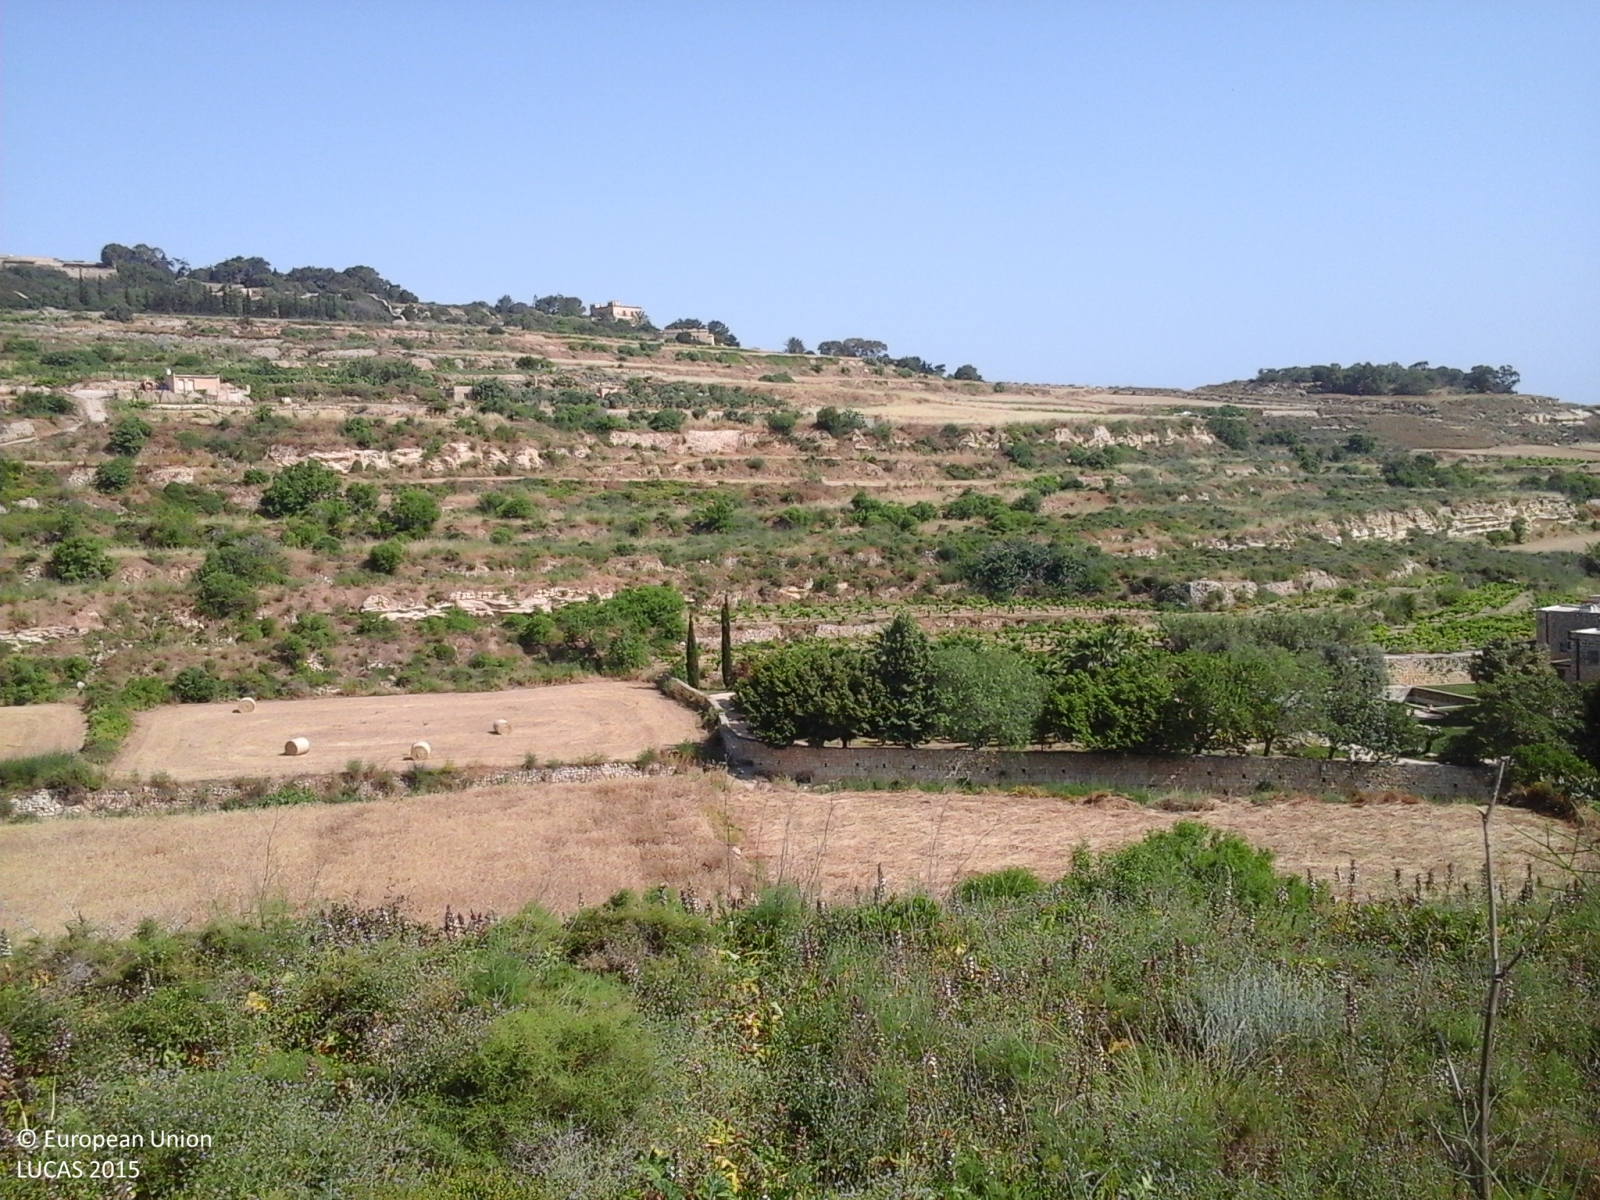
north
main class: Shrubland
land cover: Shrubland without tree cover
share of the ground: > 75 %
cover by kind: shrubs 70 %, herbaceous plants 30 %
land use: Semi-natural and natural areas not in use
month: May
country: MT
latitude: 35.9350
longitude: 14.4043
